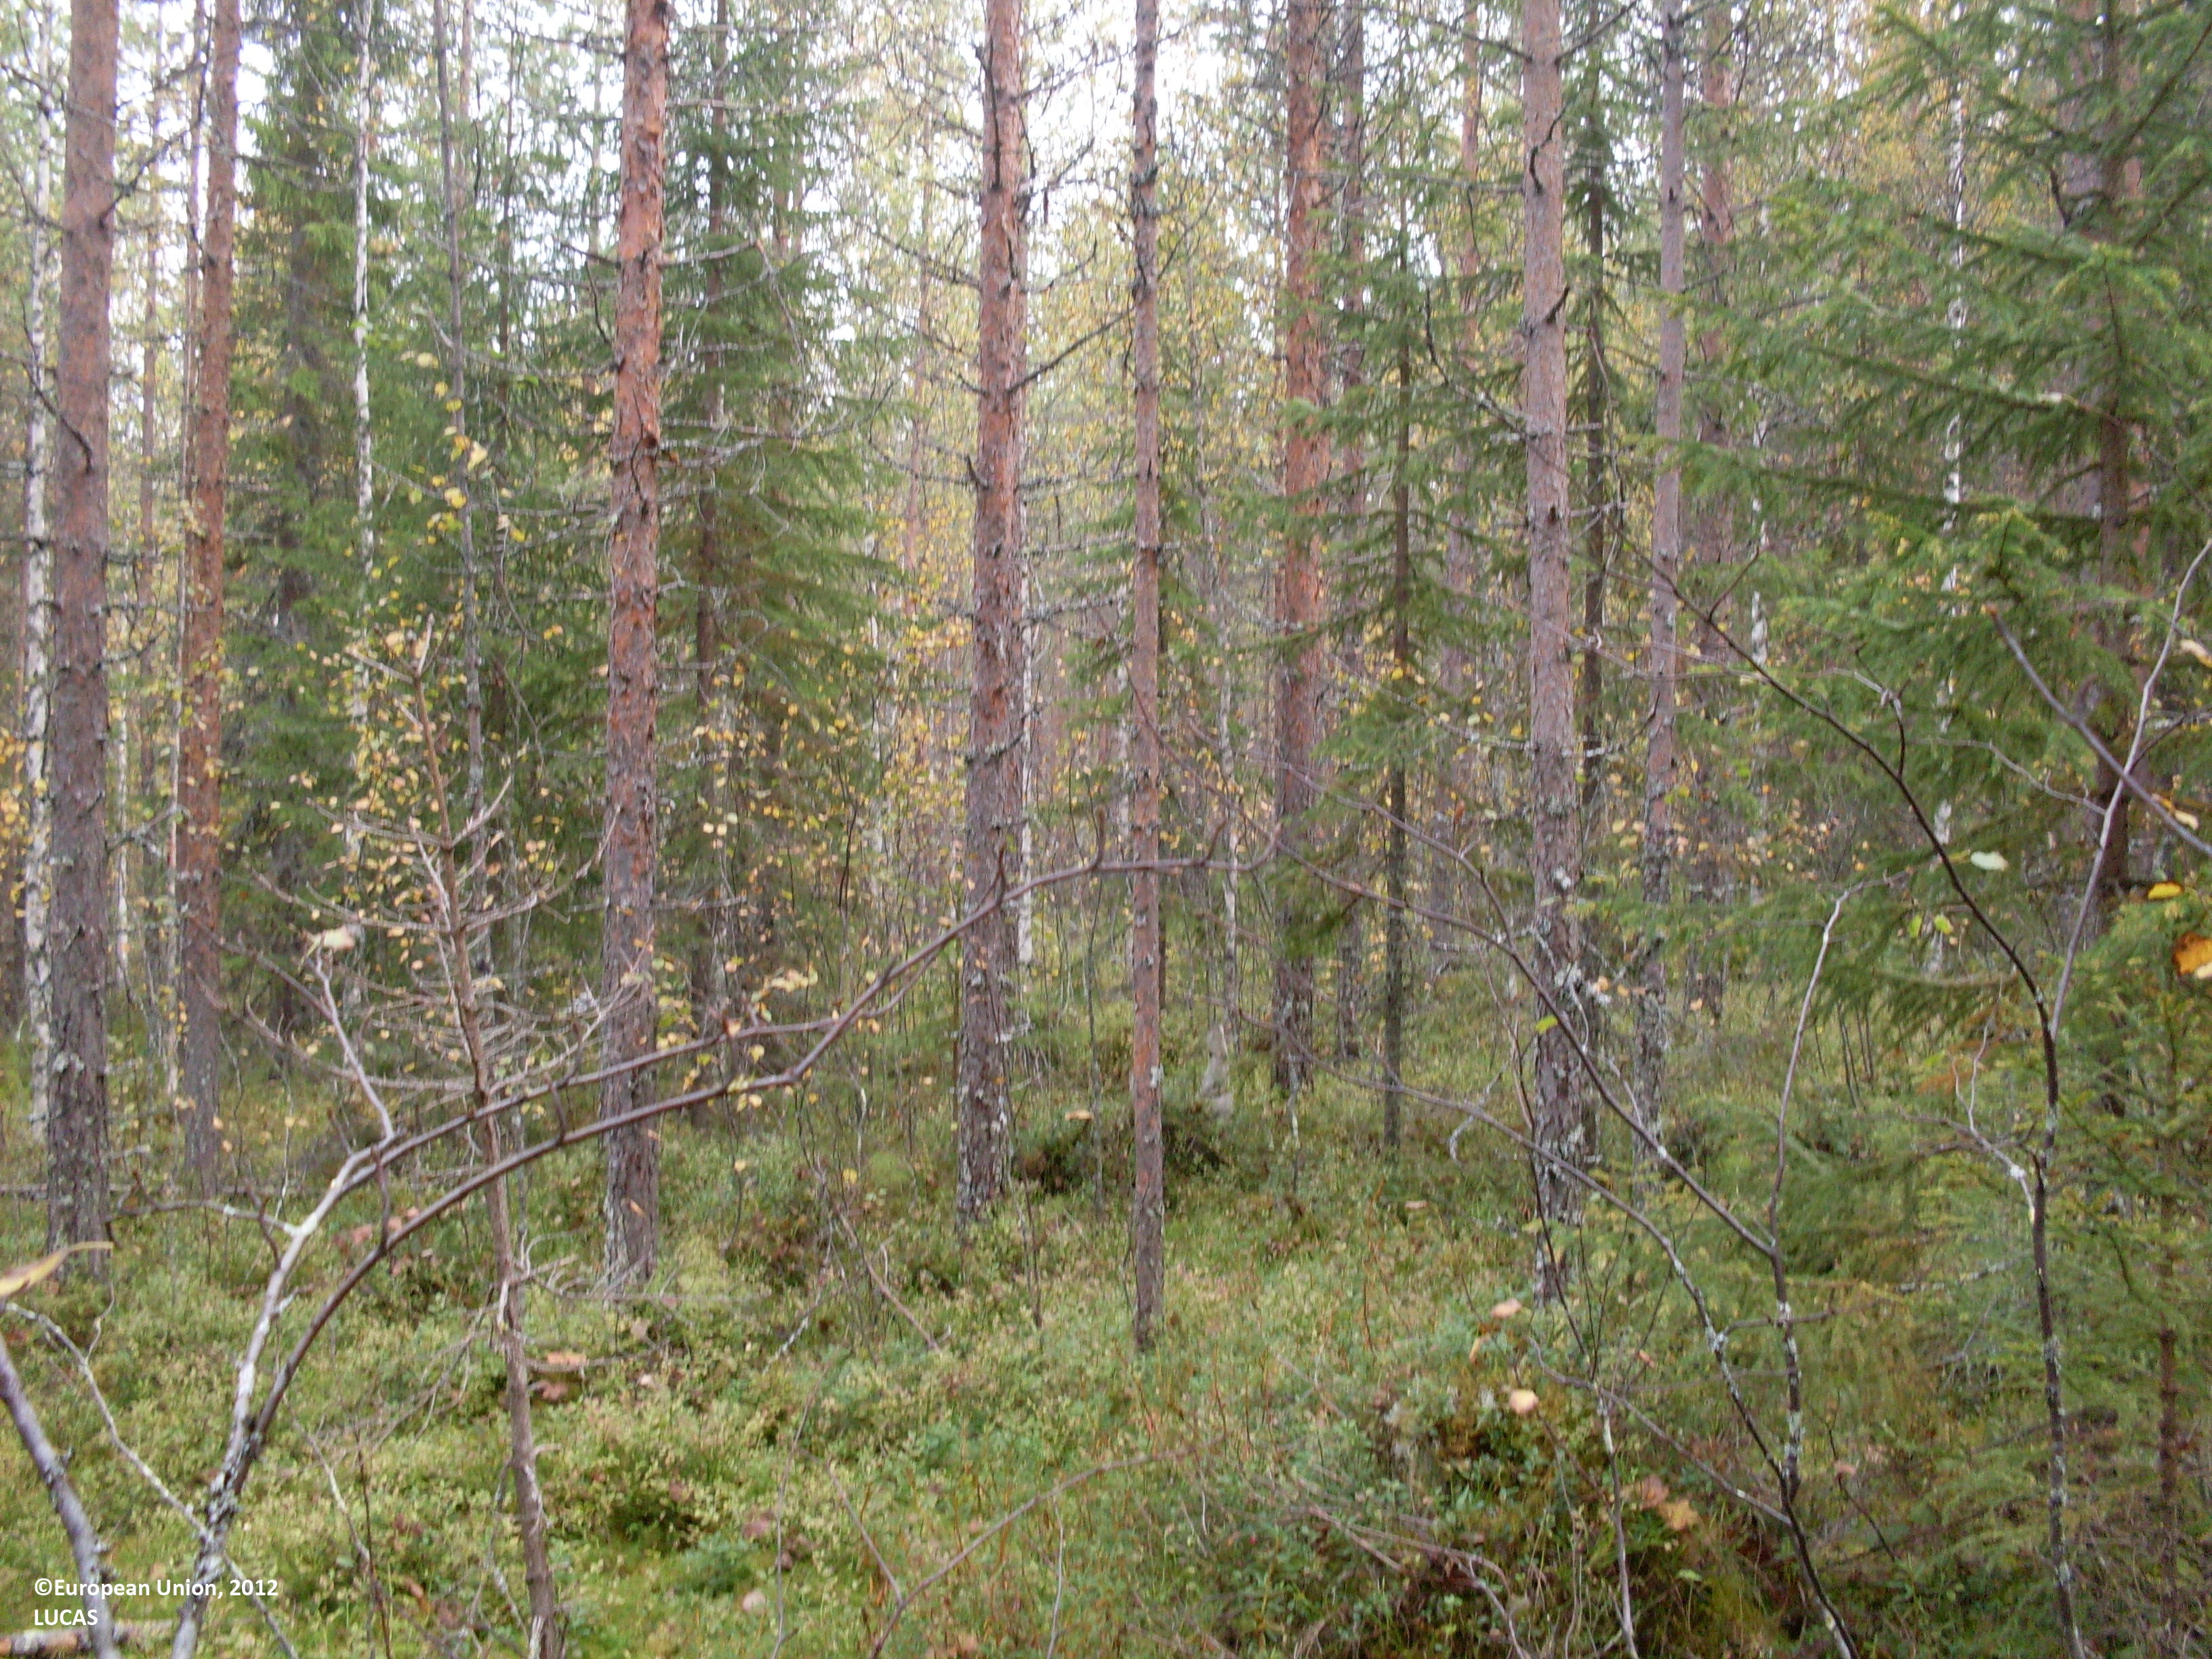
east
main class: Woodland
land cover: Pine dominated coniferous woodland
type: boreal forest
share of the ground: > 75 %
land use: Forestry
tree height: > 5 m
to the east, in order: Pine dominated coniferous woodland
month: September
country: FI
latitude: 64.2655
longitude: 30.2931
